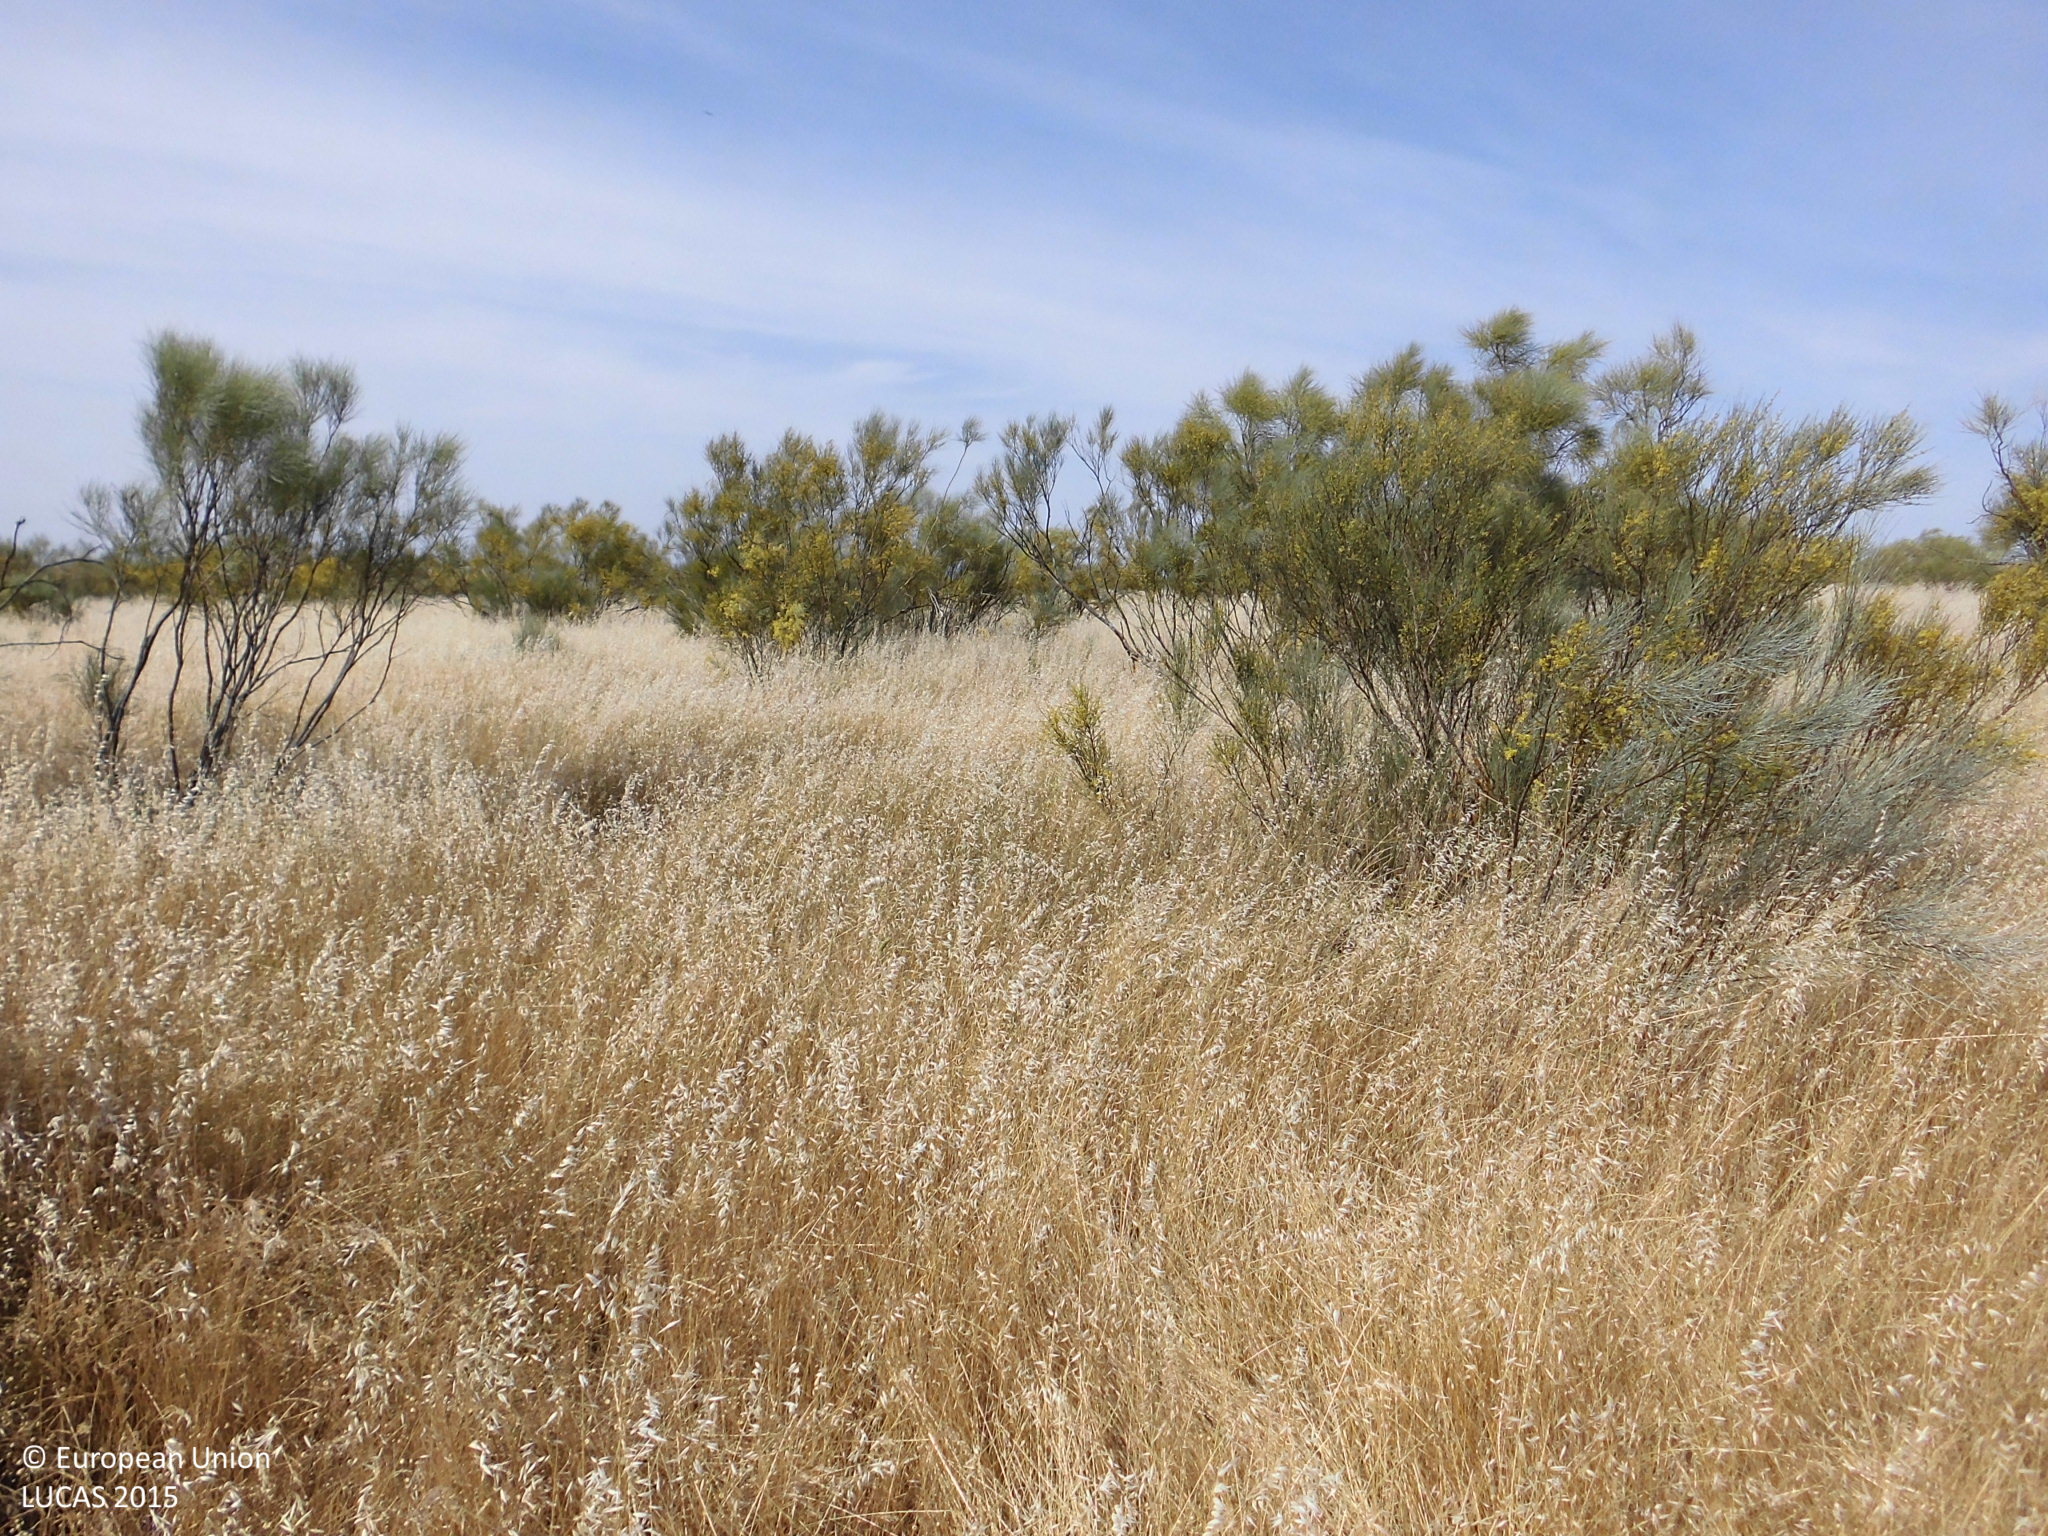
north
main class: Shrubland
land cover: Shrubland without tree cover
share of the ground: 10 - 25 %
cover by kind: herbaceous plants 85 %, shrubs 15 %
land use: Semi-natural and natural areas not in use
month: May
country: ES
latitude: 39.4608
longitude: -5.9947
